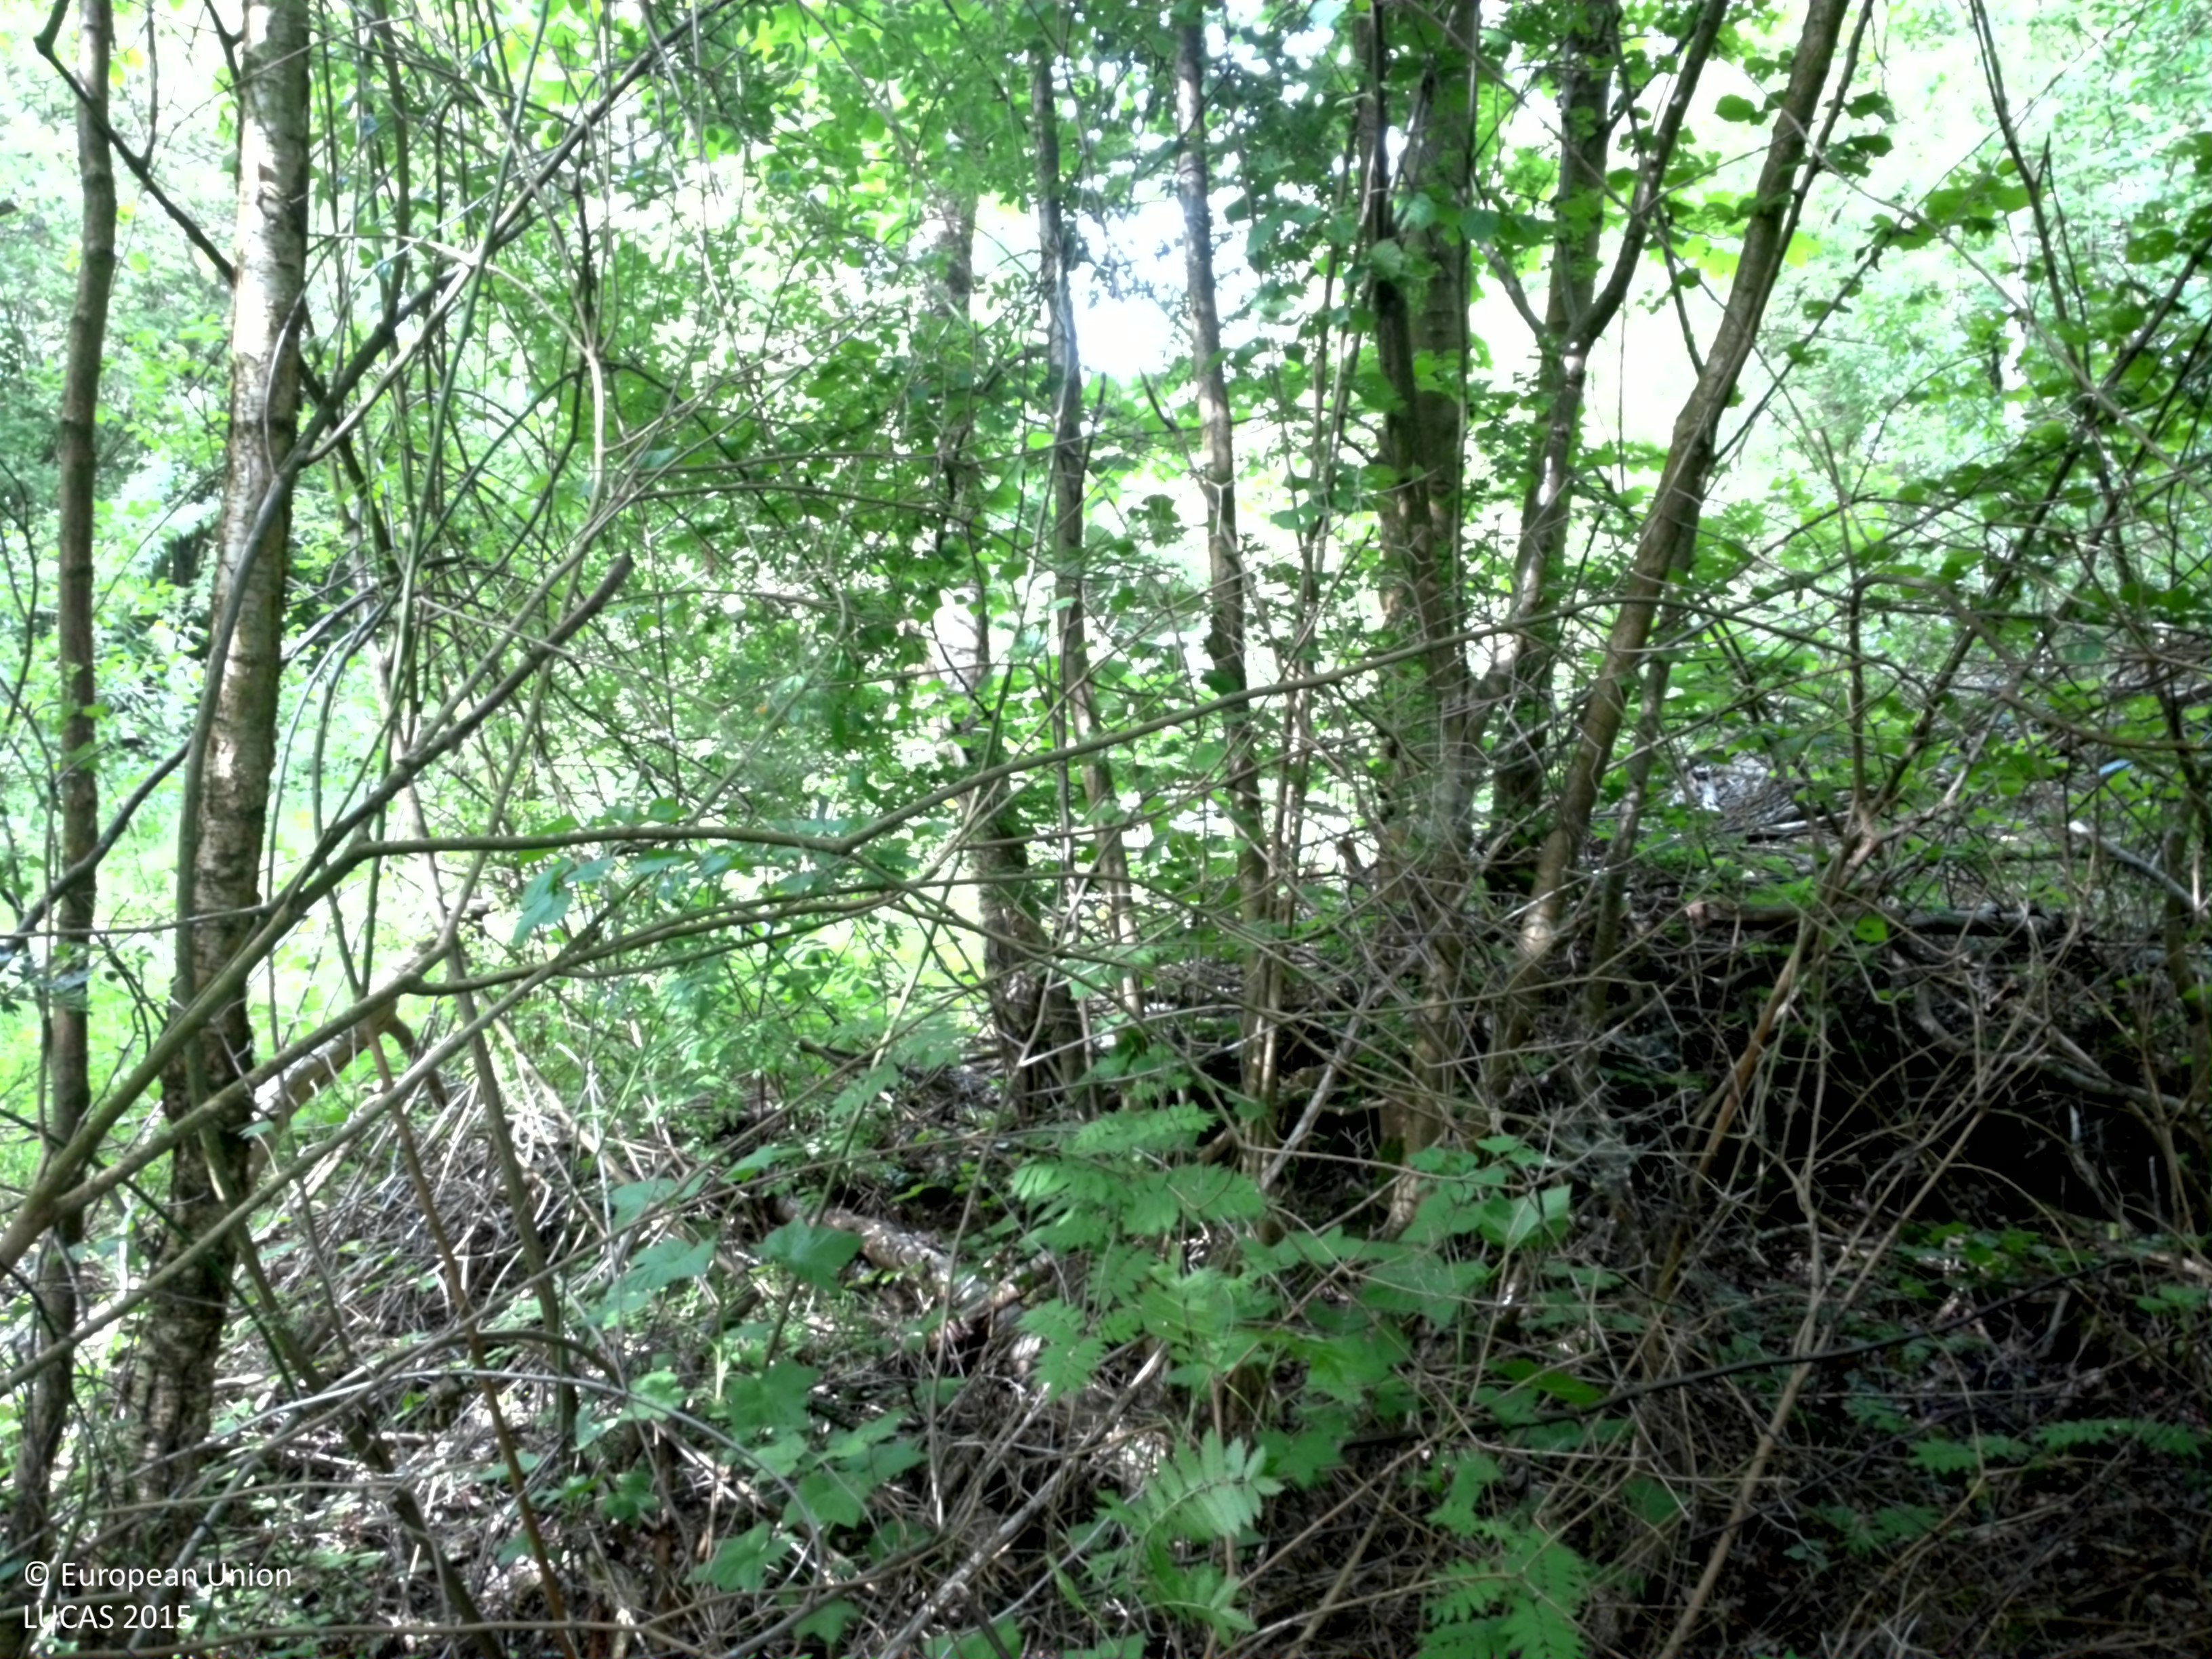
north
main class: Woodland
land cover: Broadleaved woodland
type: mesophytic deciduous forest
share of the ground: > 75 %
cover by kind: broadleaved forest trees 85 %, herbaceous plants 15 %
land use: Amenities, museums, leisure
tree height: > 5 m
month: June
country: SE
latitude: 55.7732
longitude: 13.0745
